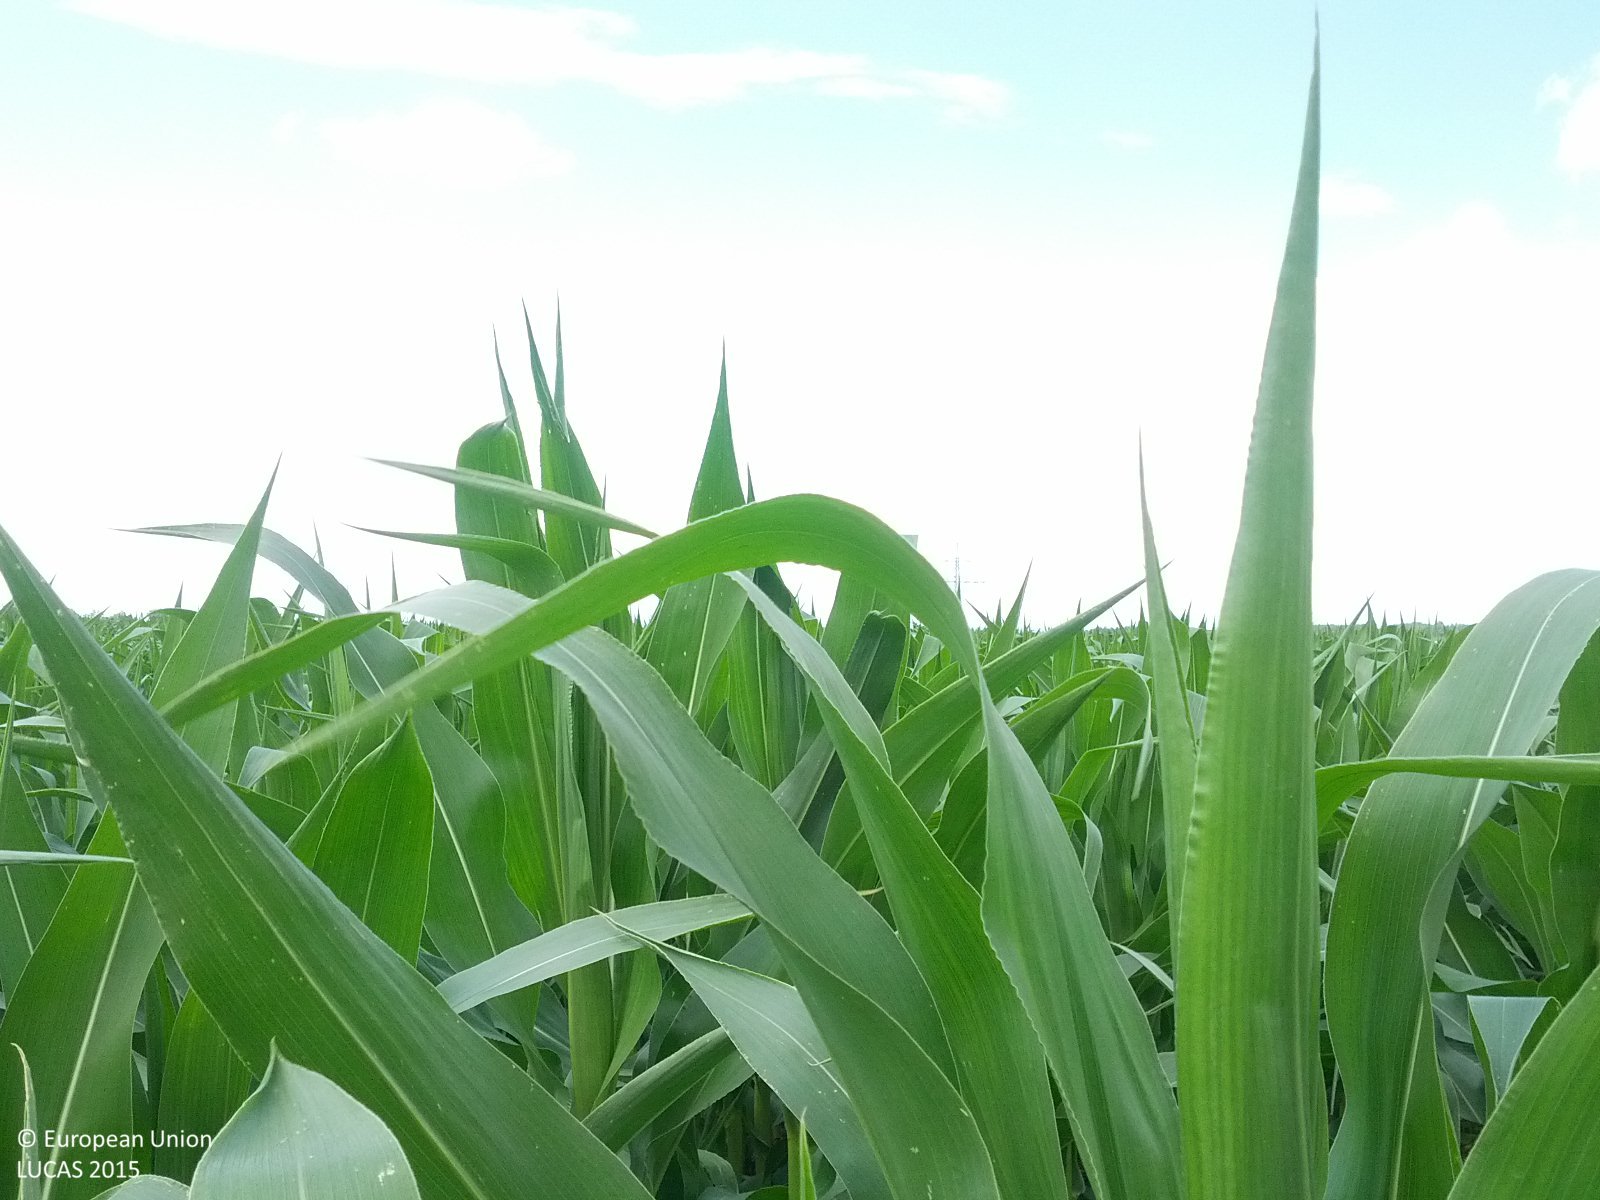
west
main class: Cropland
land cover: Maize
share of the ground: > 75 %
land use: Agriculture (excluding fallow land and kitchen gardens)
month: July
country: AT
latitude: 48.7081
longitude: 16.3520
